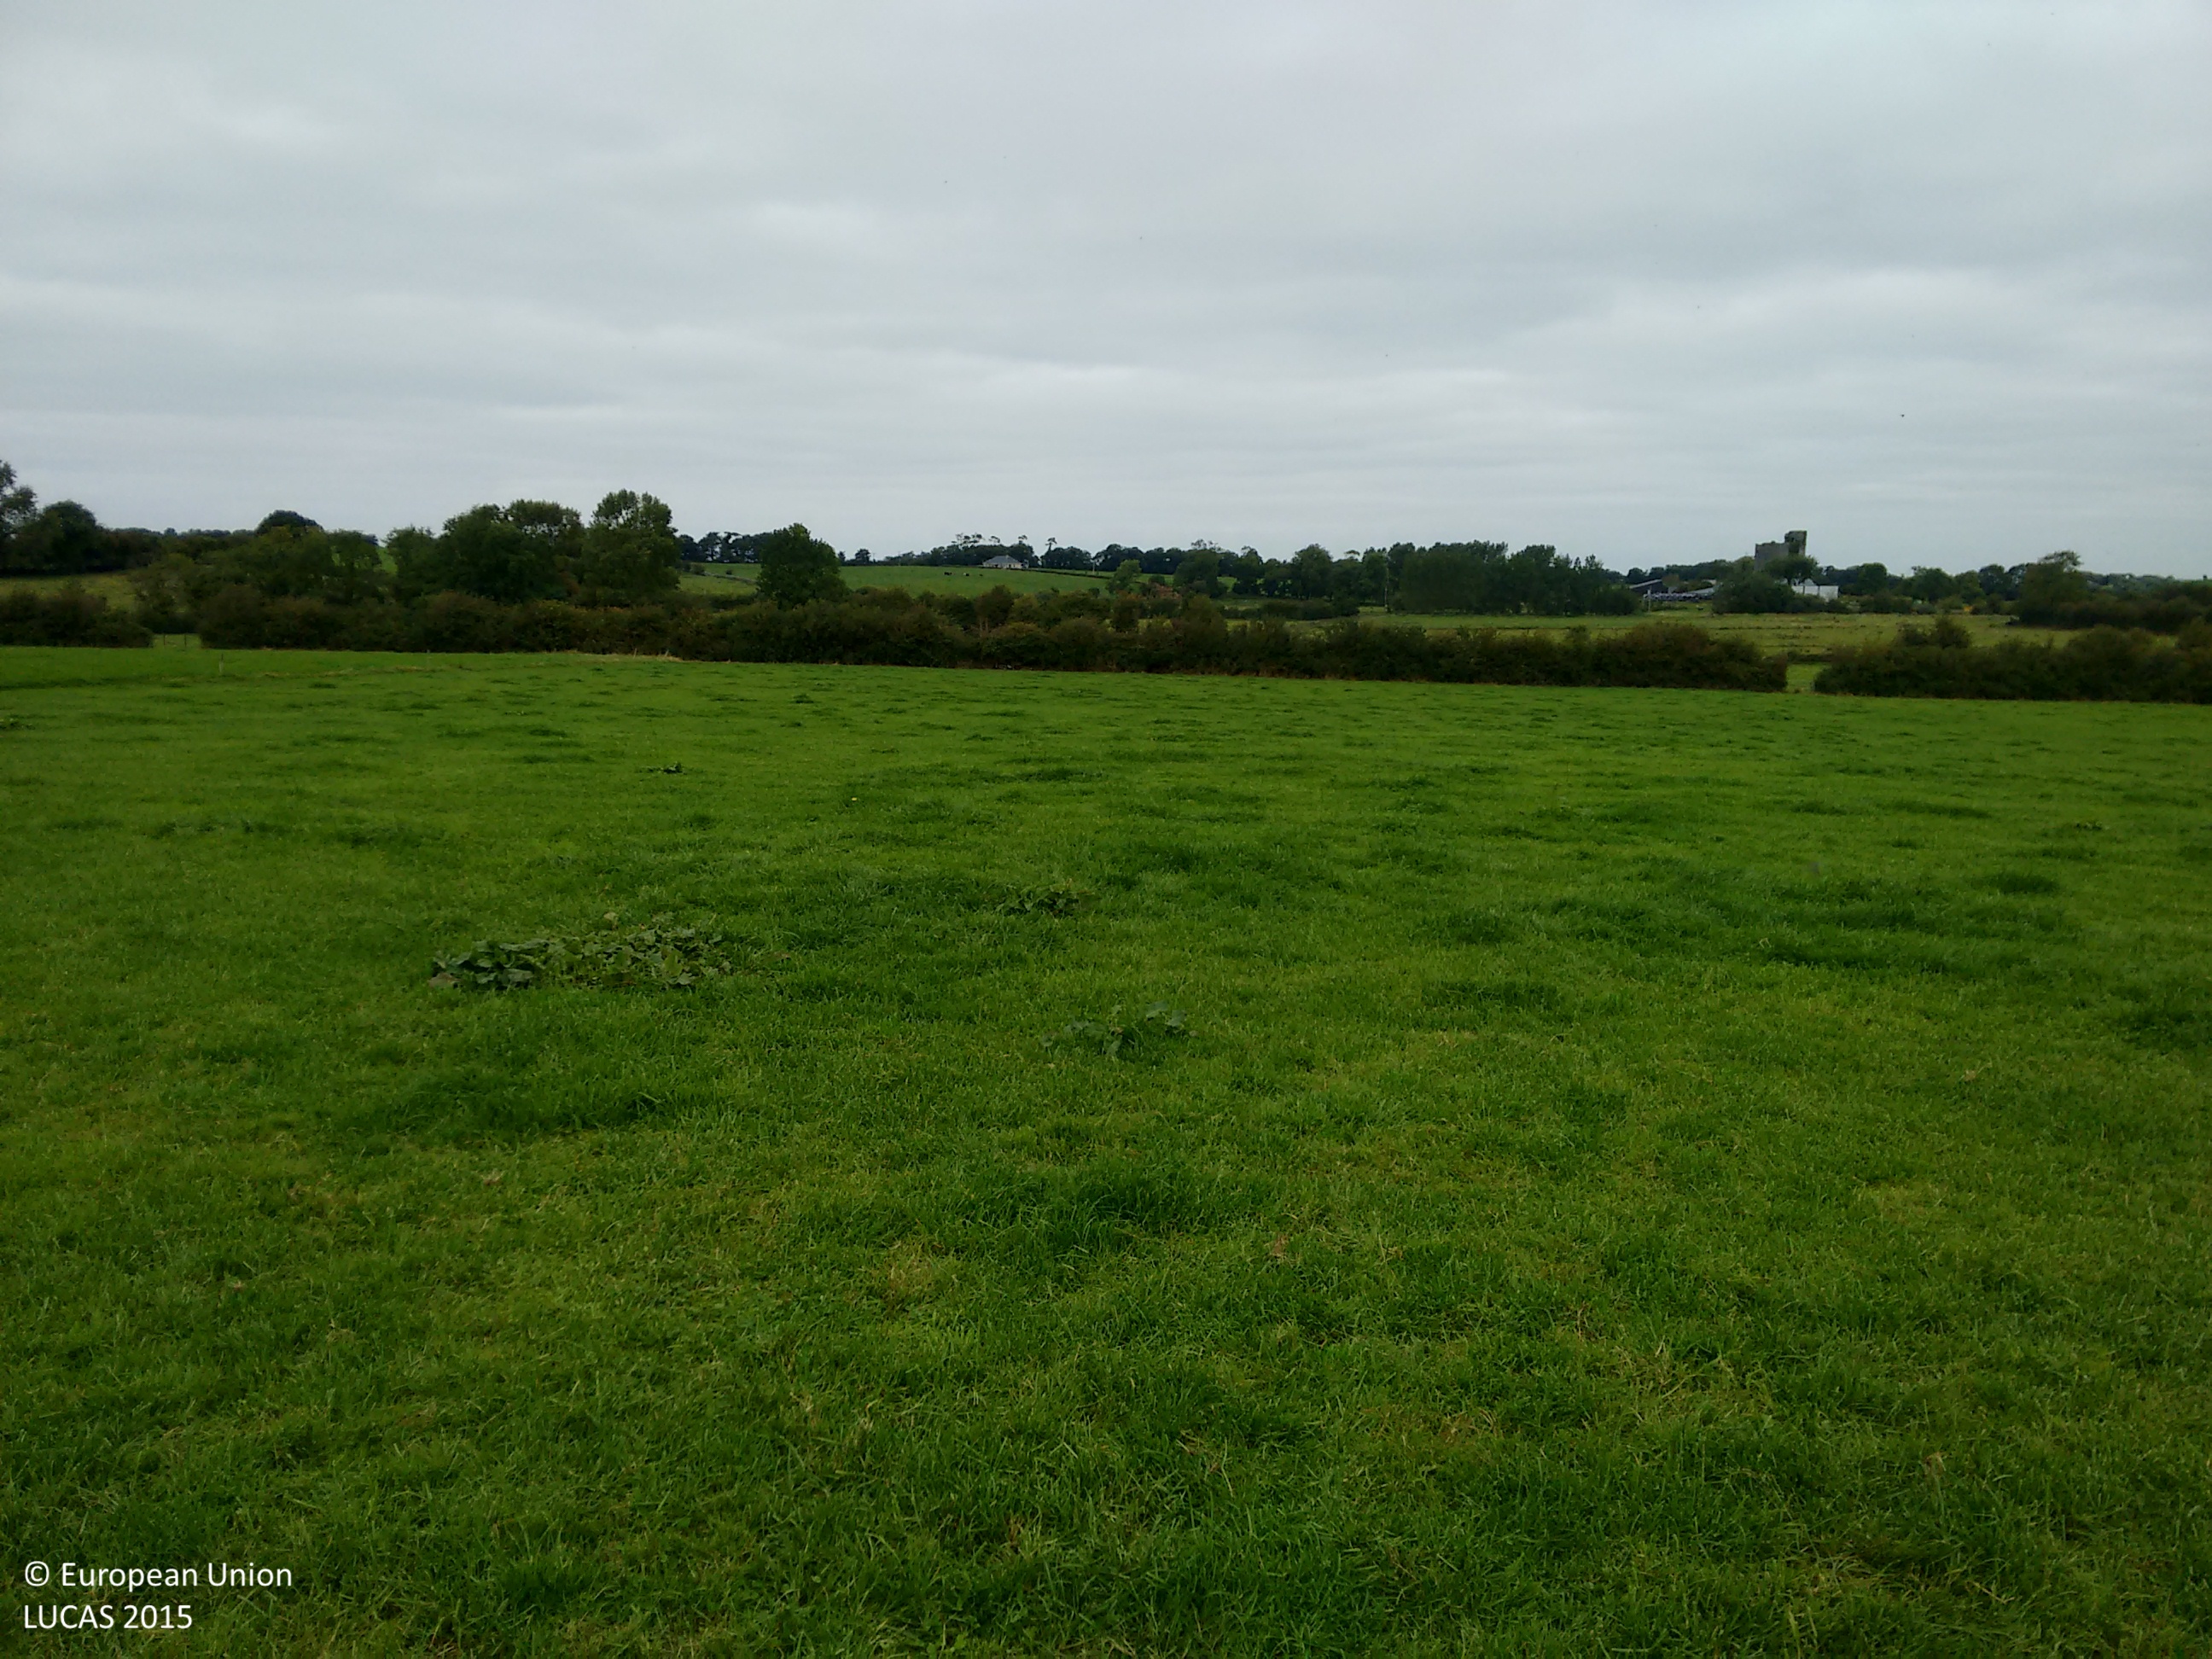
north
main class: Grassland
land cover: Grassland without tree/shrub cover
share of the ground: > 75 %
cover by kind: herbaceous plants 100 %
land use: Agriculture (excluding fallow land and kitchen gardens)
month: September
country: IE
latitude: 52.5232
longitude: -9.0049
